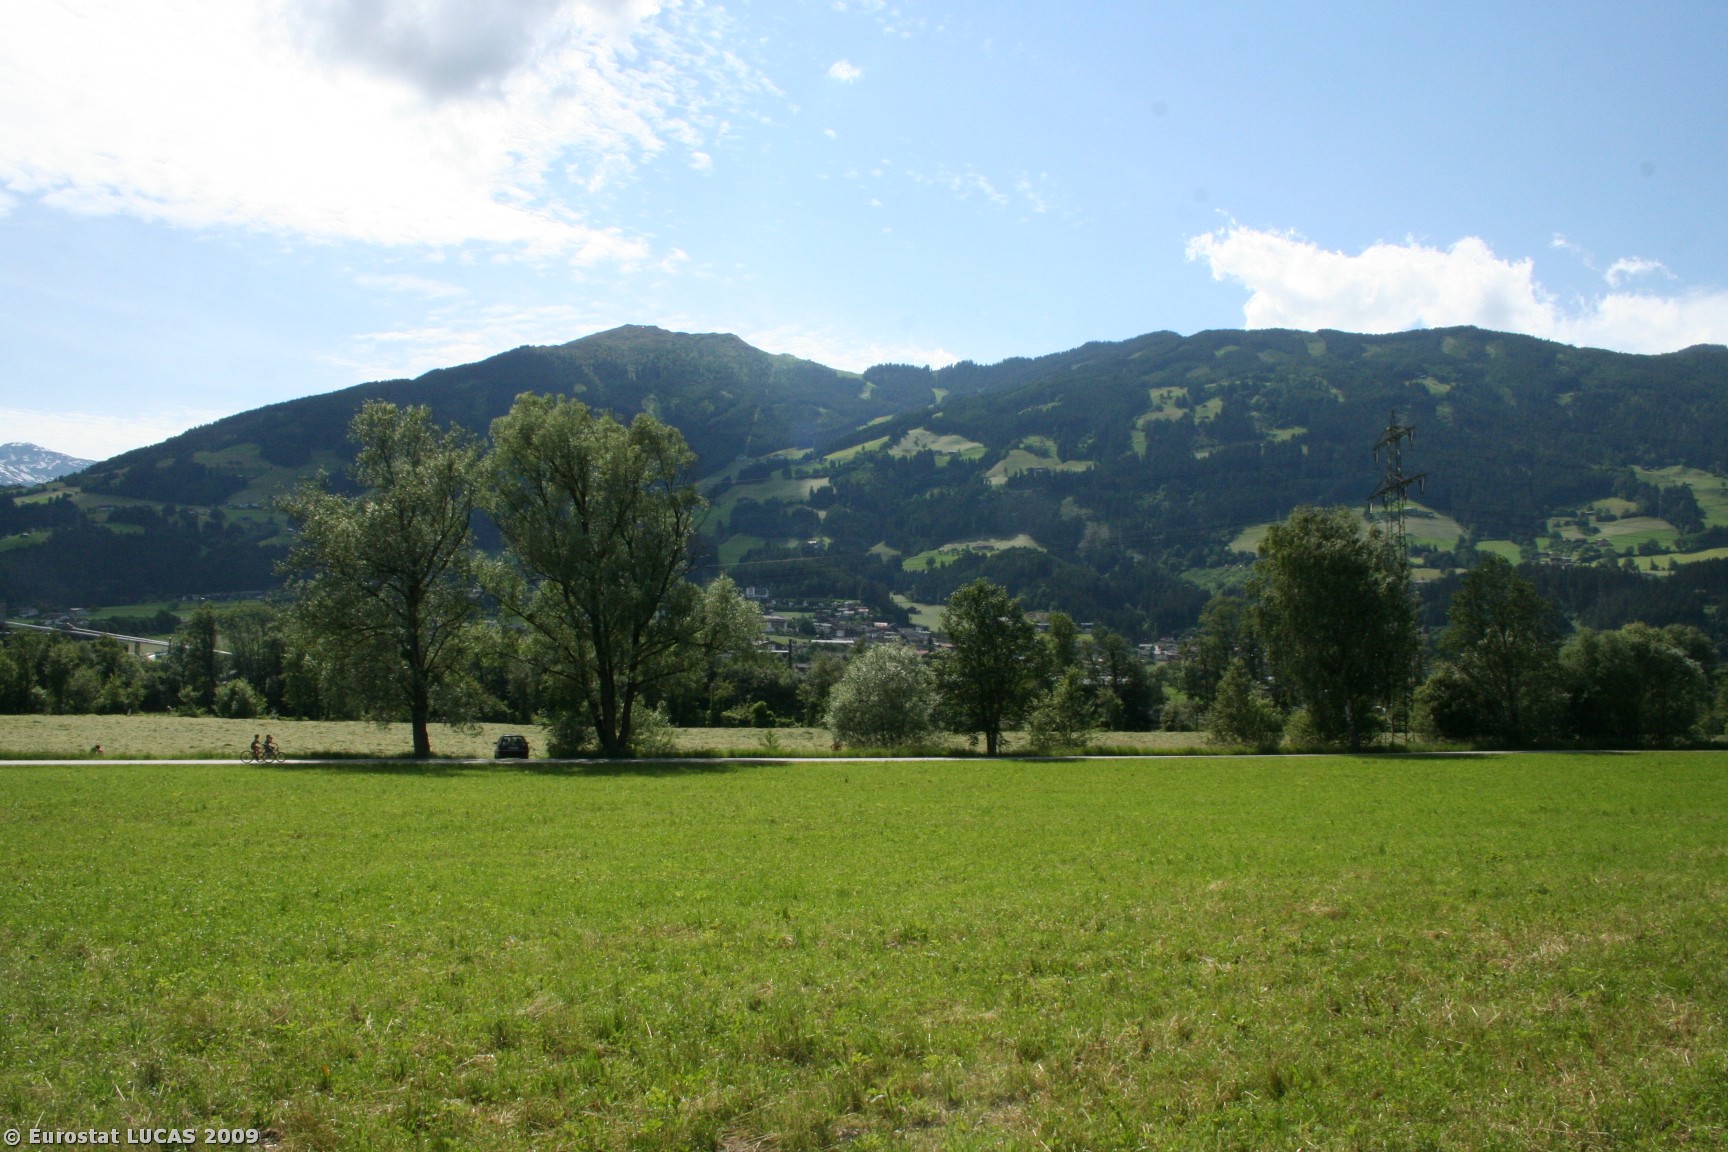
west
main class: Grassland
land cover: Grassland without tree/shrub cover
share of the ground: > 75 %
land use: Agriculture (excluding fallow land and kitchen gardens)
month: June
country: AT
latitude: 47.3436
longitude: 11.8647
